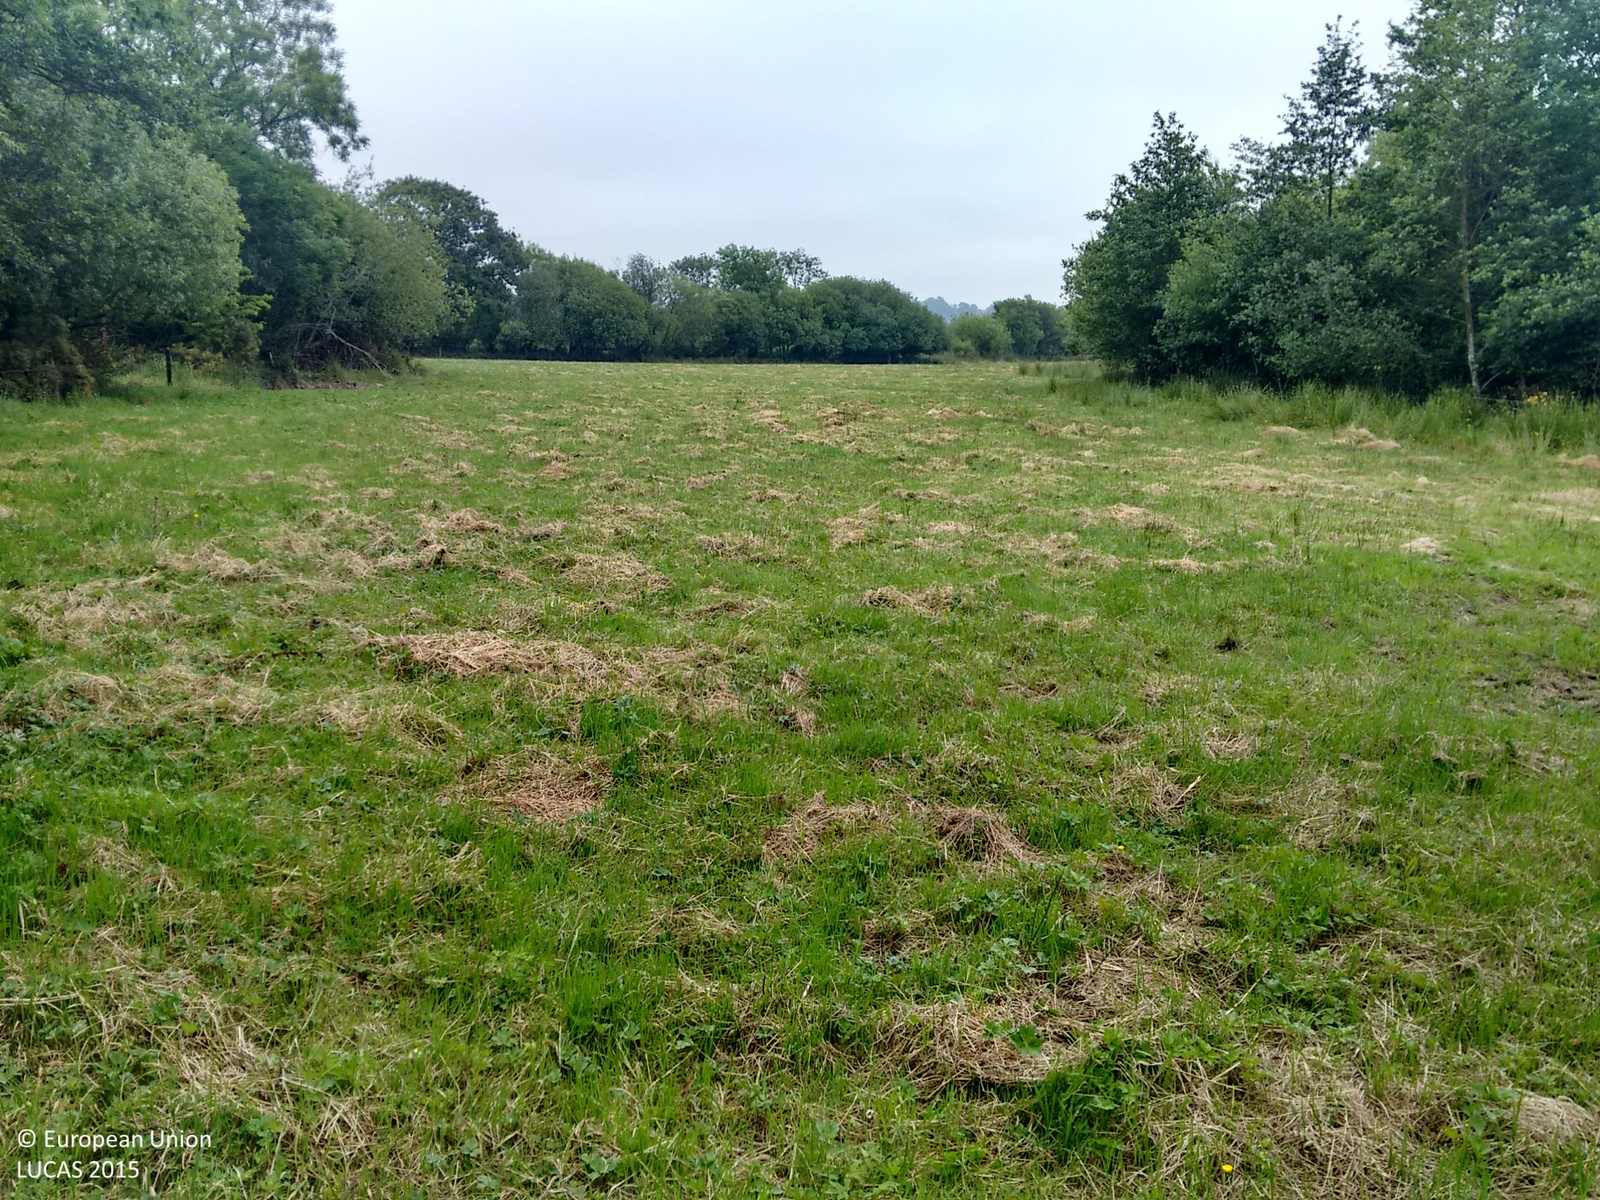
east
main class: Grassland
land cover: Grassland without tree/shrub cover
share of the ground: > 75 %
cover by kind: herbaceous plants 100 %
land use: Agriculture (excluding fallow land and kitchen gardens)
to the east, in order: Grassland without tree/shrub cover; Fences; Ditches and canals; Abandoned hedges; Fences; Tracks; Fences; Abandoned hedges; Ditches and canals; Grass margins; Fences; Grassland without tree/shrub cover; Fences; Ditches and canals; Fences; Grassland without tree/shrub cover; Fences; Ditches and canals; Fences; Grassland without tree/shrub cover
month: June
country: IE
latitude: 52.2474
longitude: -7.2133
